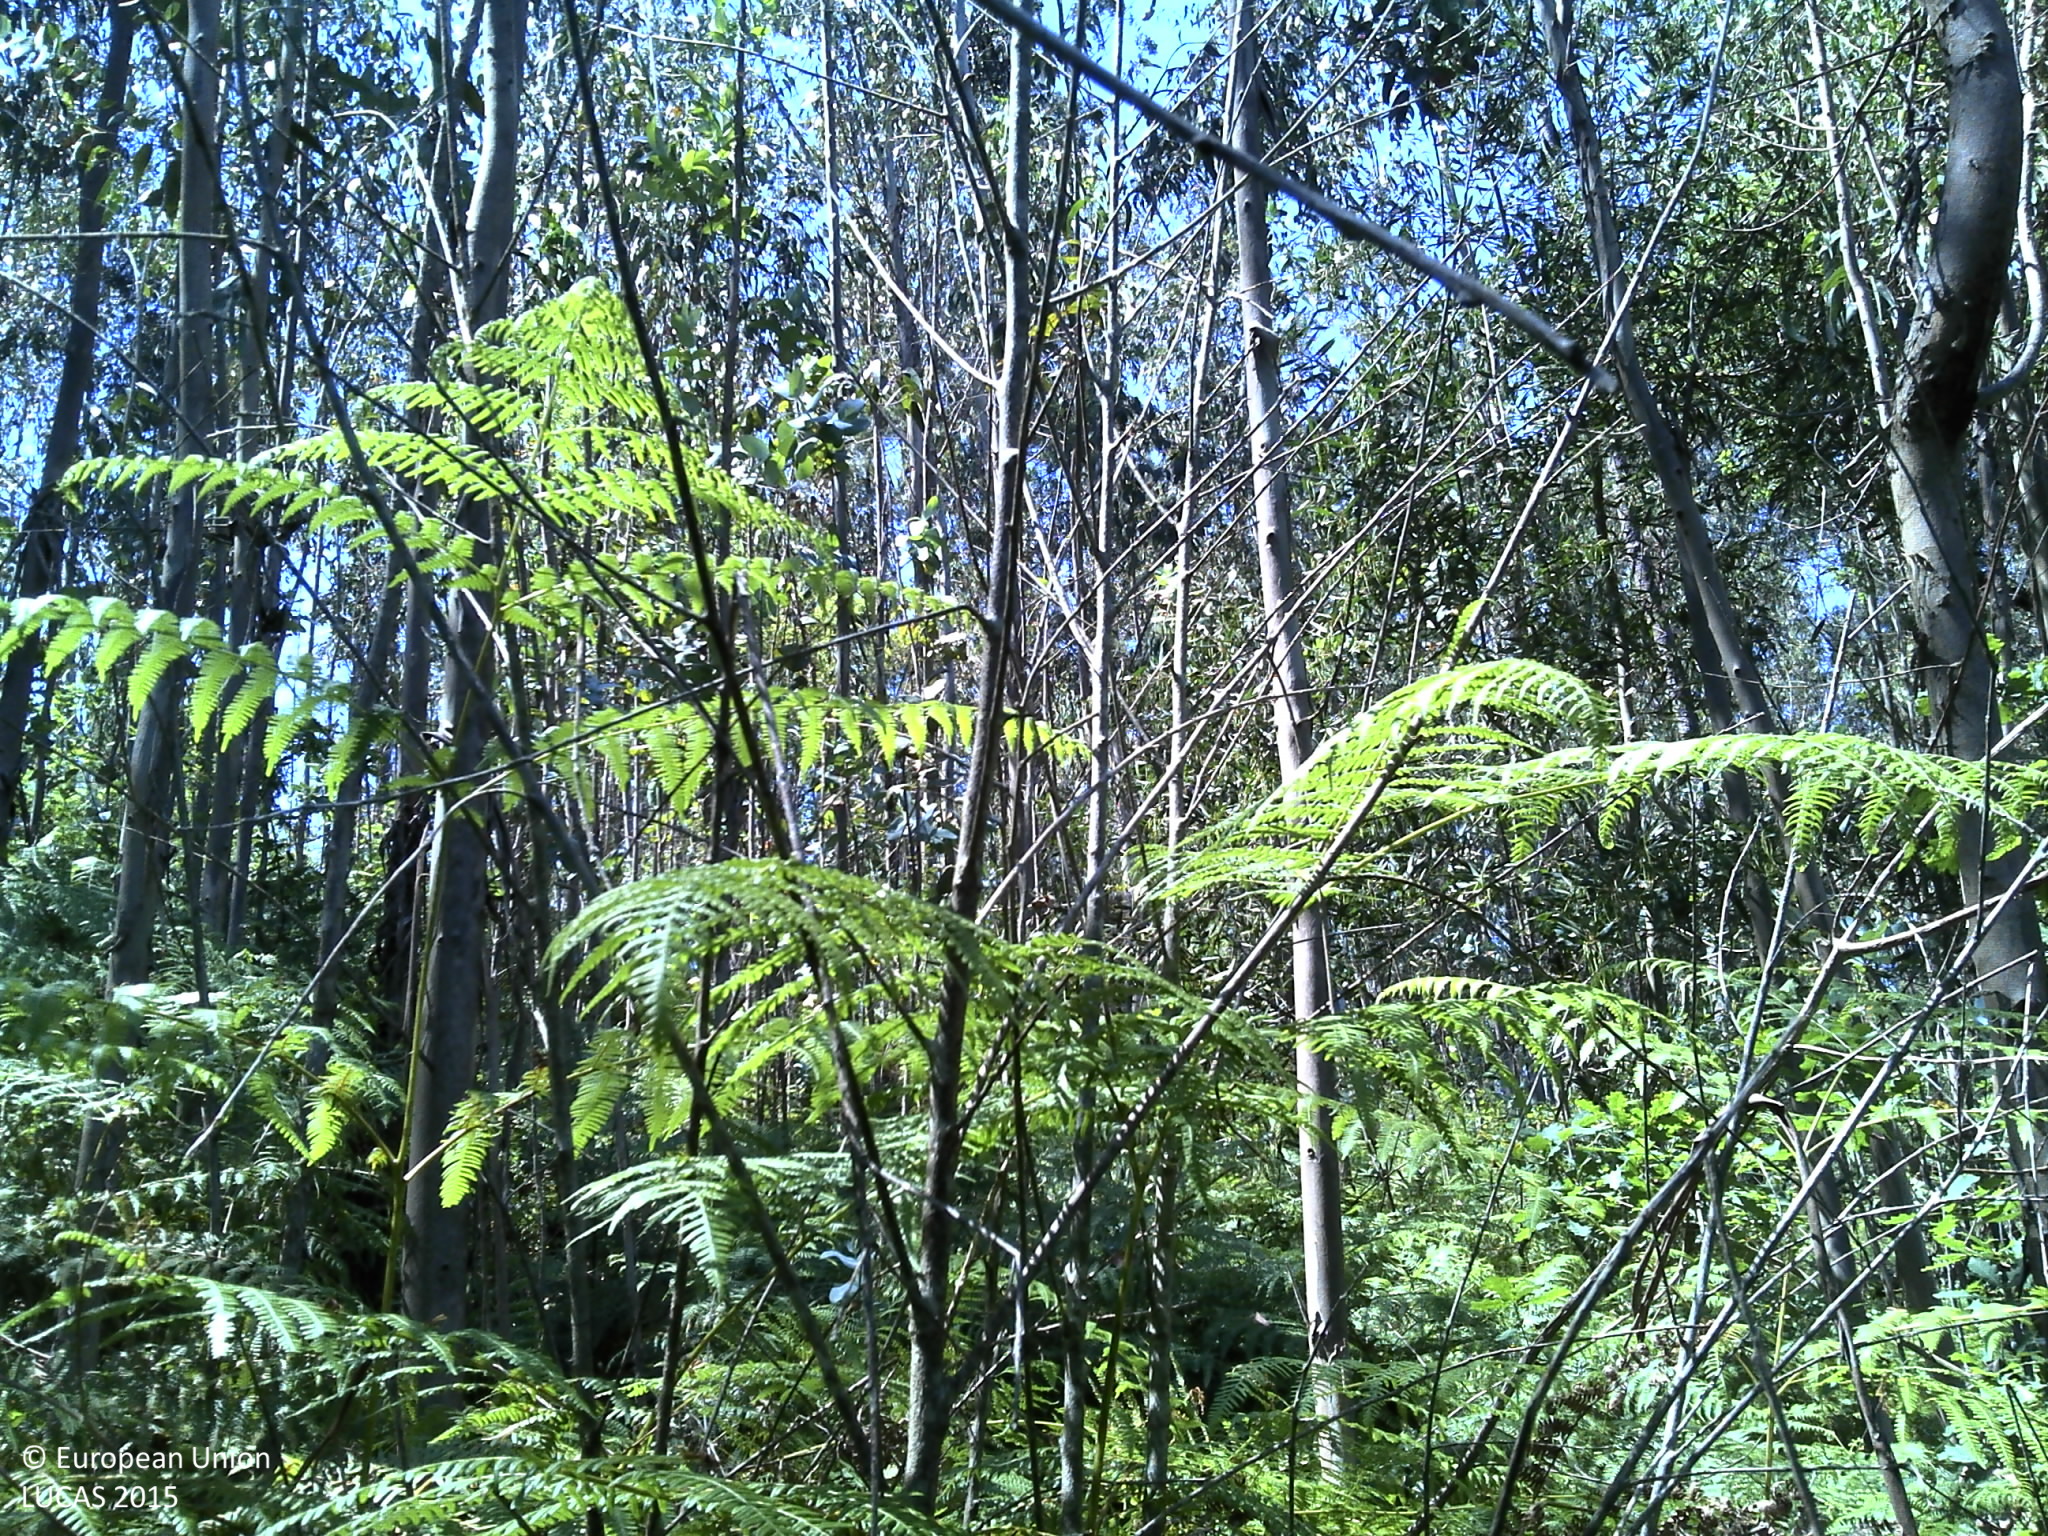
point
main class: Woodland
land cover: Broadleaved woodland
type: exotic forest
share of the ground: 50 - 75 %
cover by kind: broadleaved forest trees 60 %, shrubs 40 %
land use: Forestry
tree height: > 5 m
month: May
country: PT
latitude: 41.8284
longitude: -8.6473
